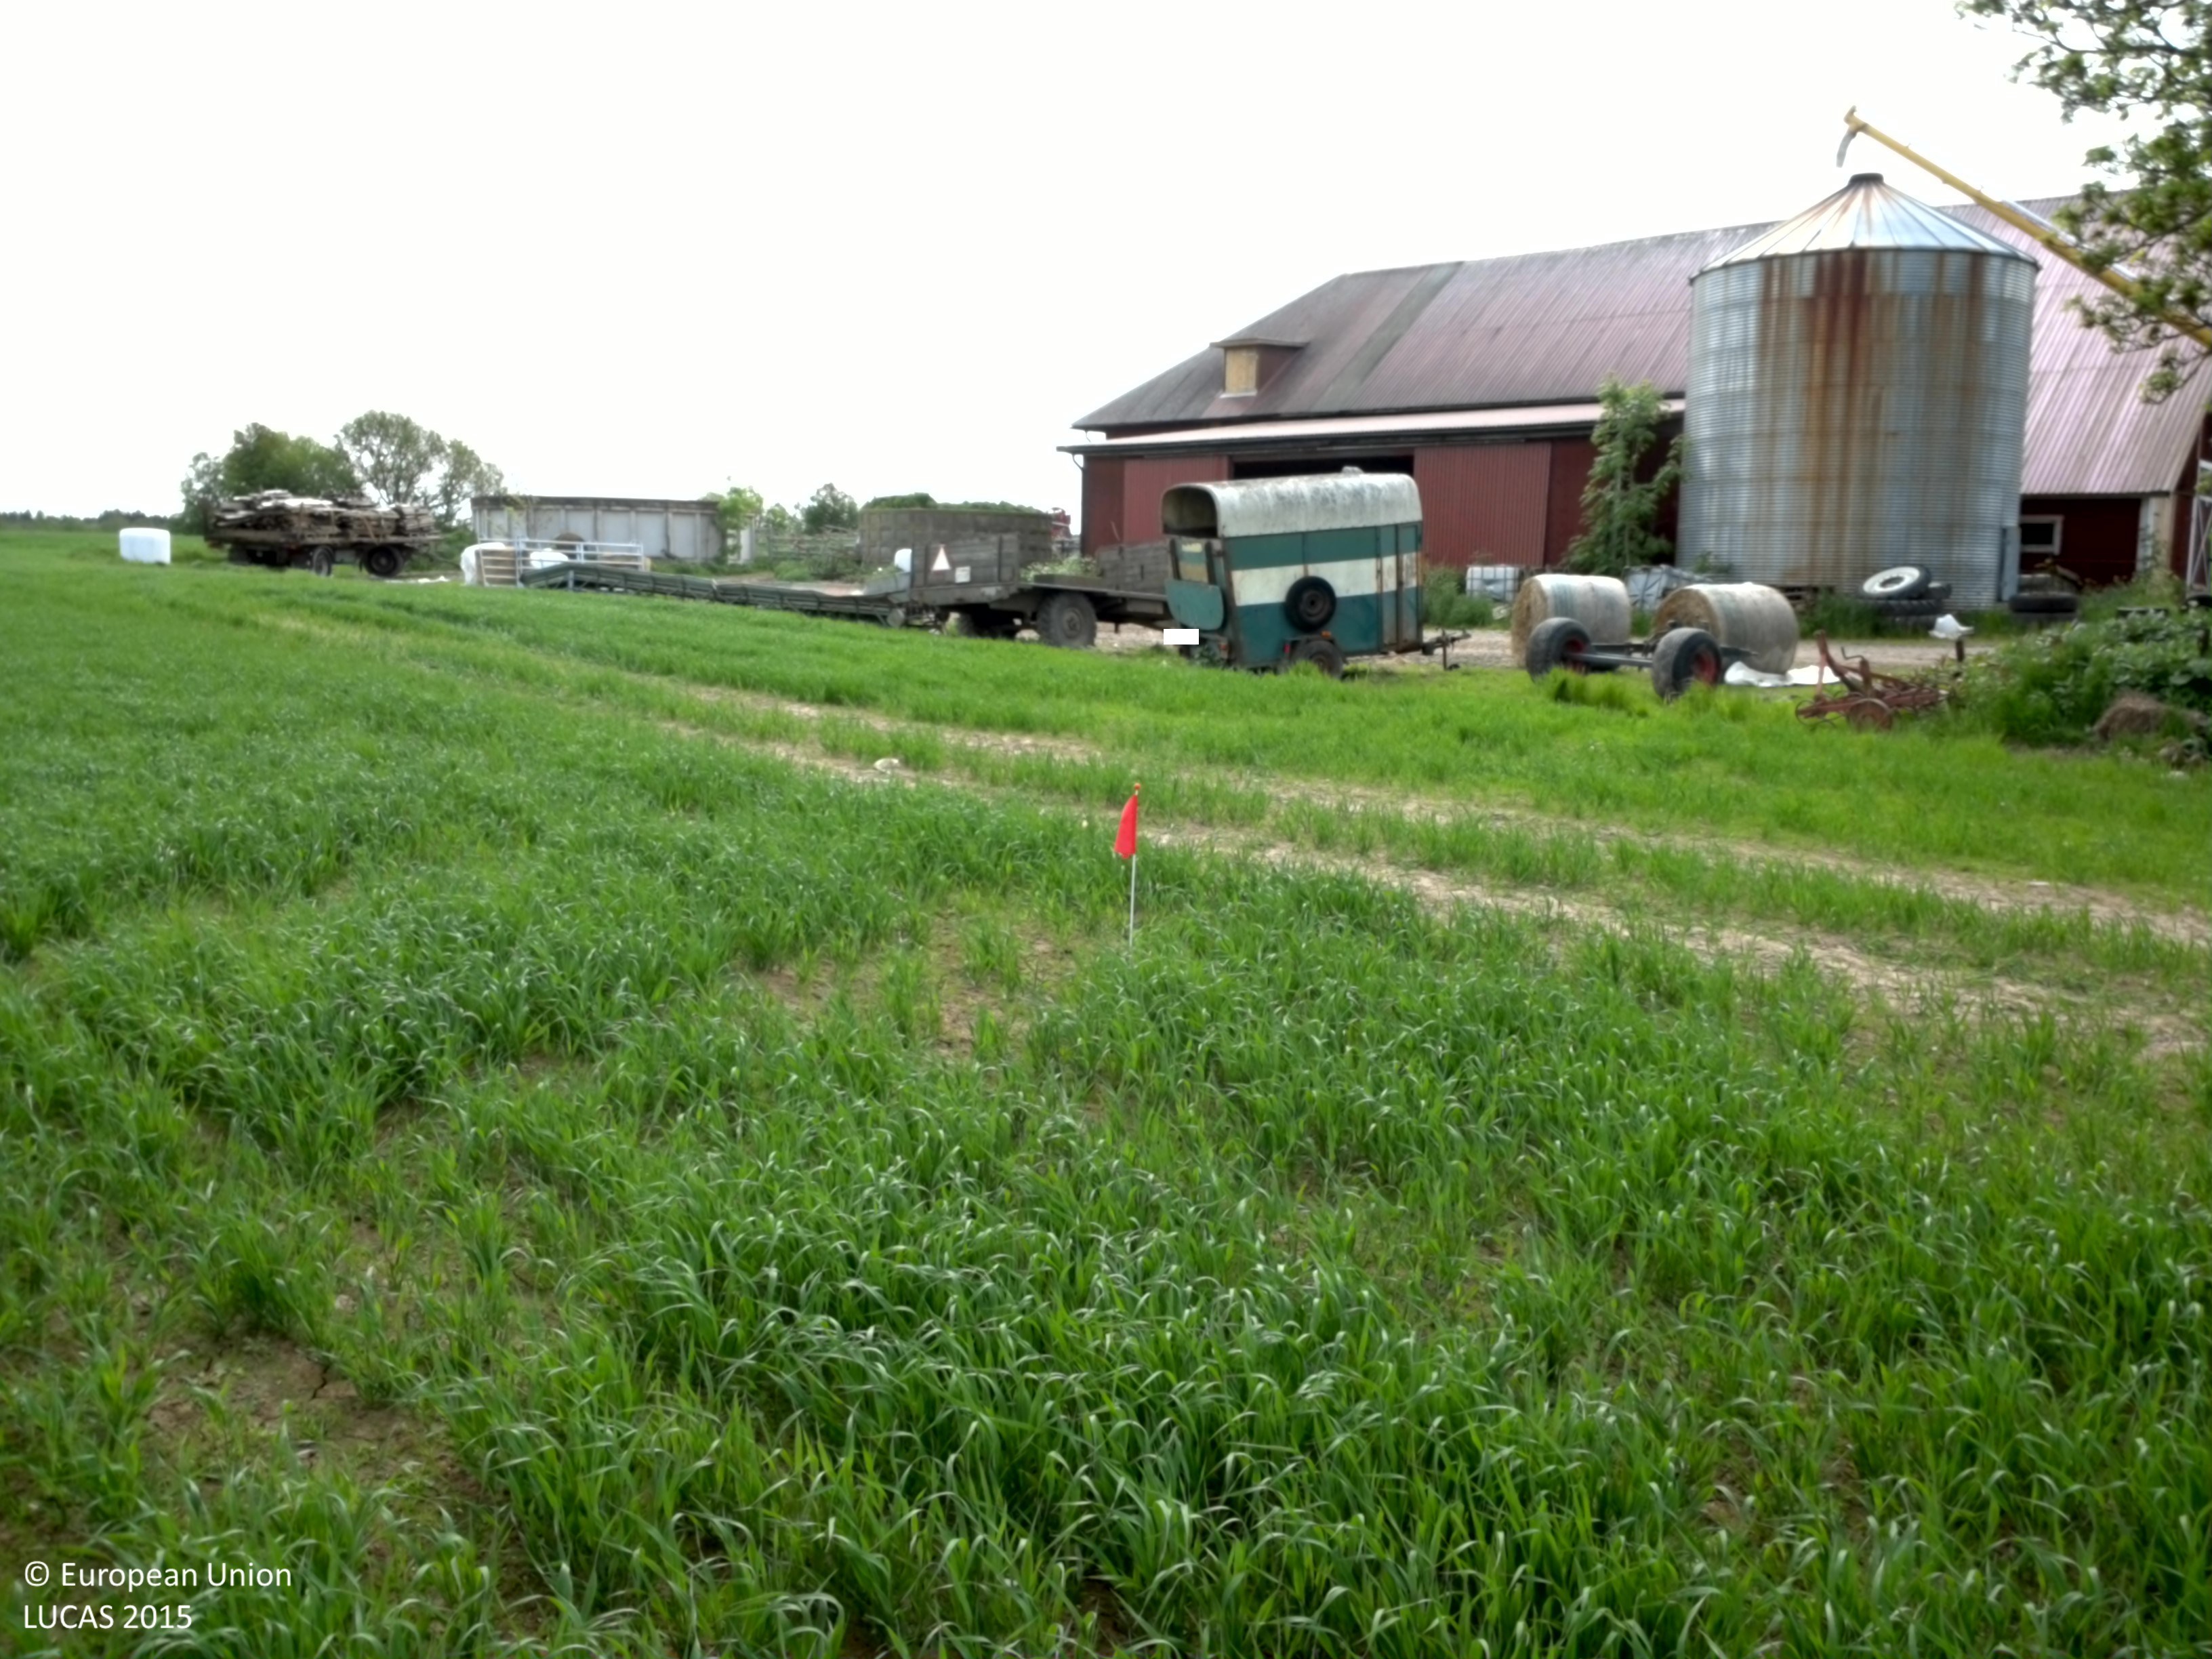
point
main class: Cropland
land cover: Oats
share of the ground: > 75 %
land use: Agriculture (excluding fallow land and kitchen gardens)
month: June
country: SE
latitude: 58.4147
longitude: 13.9137
